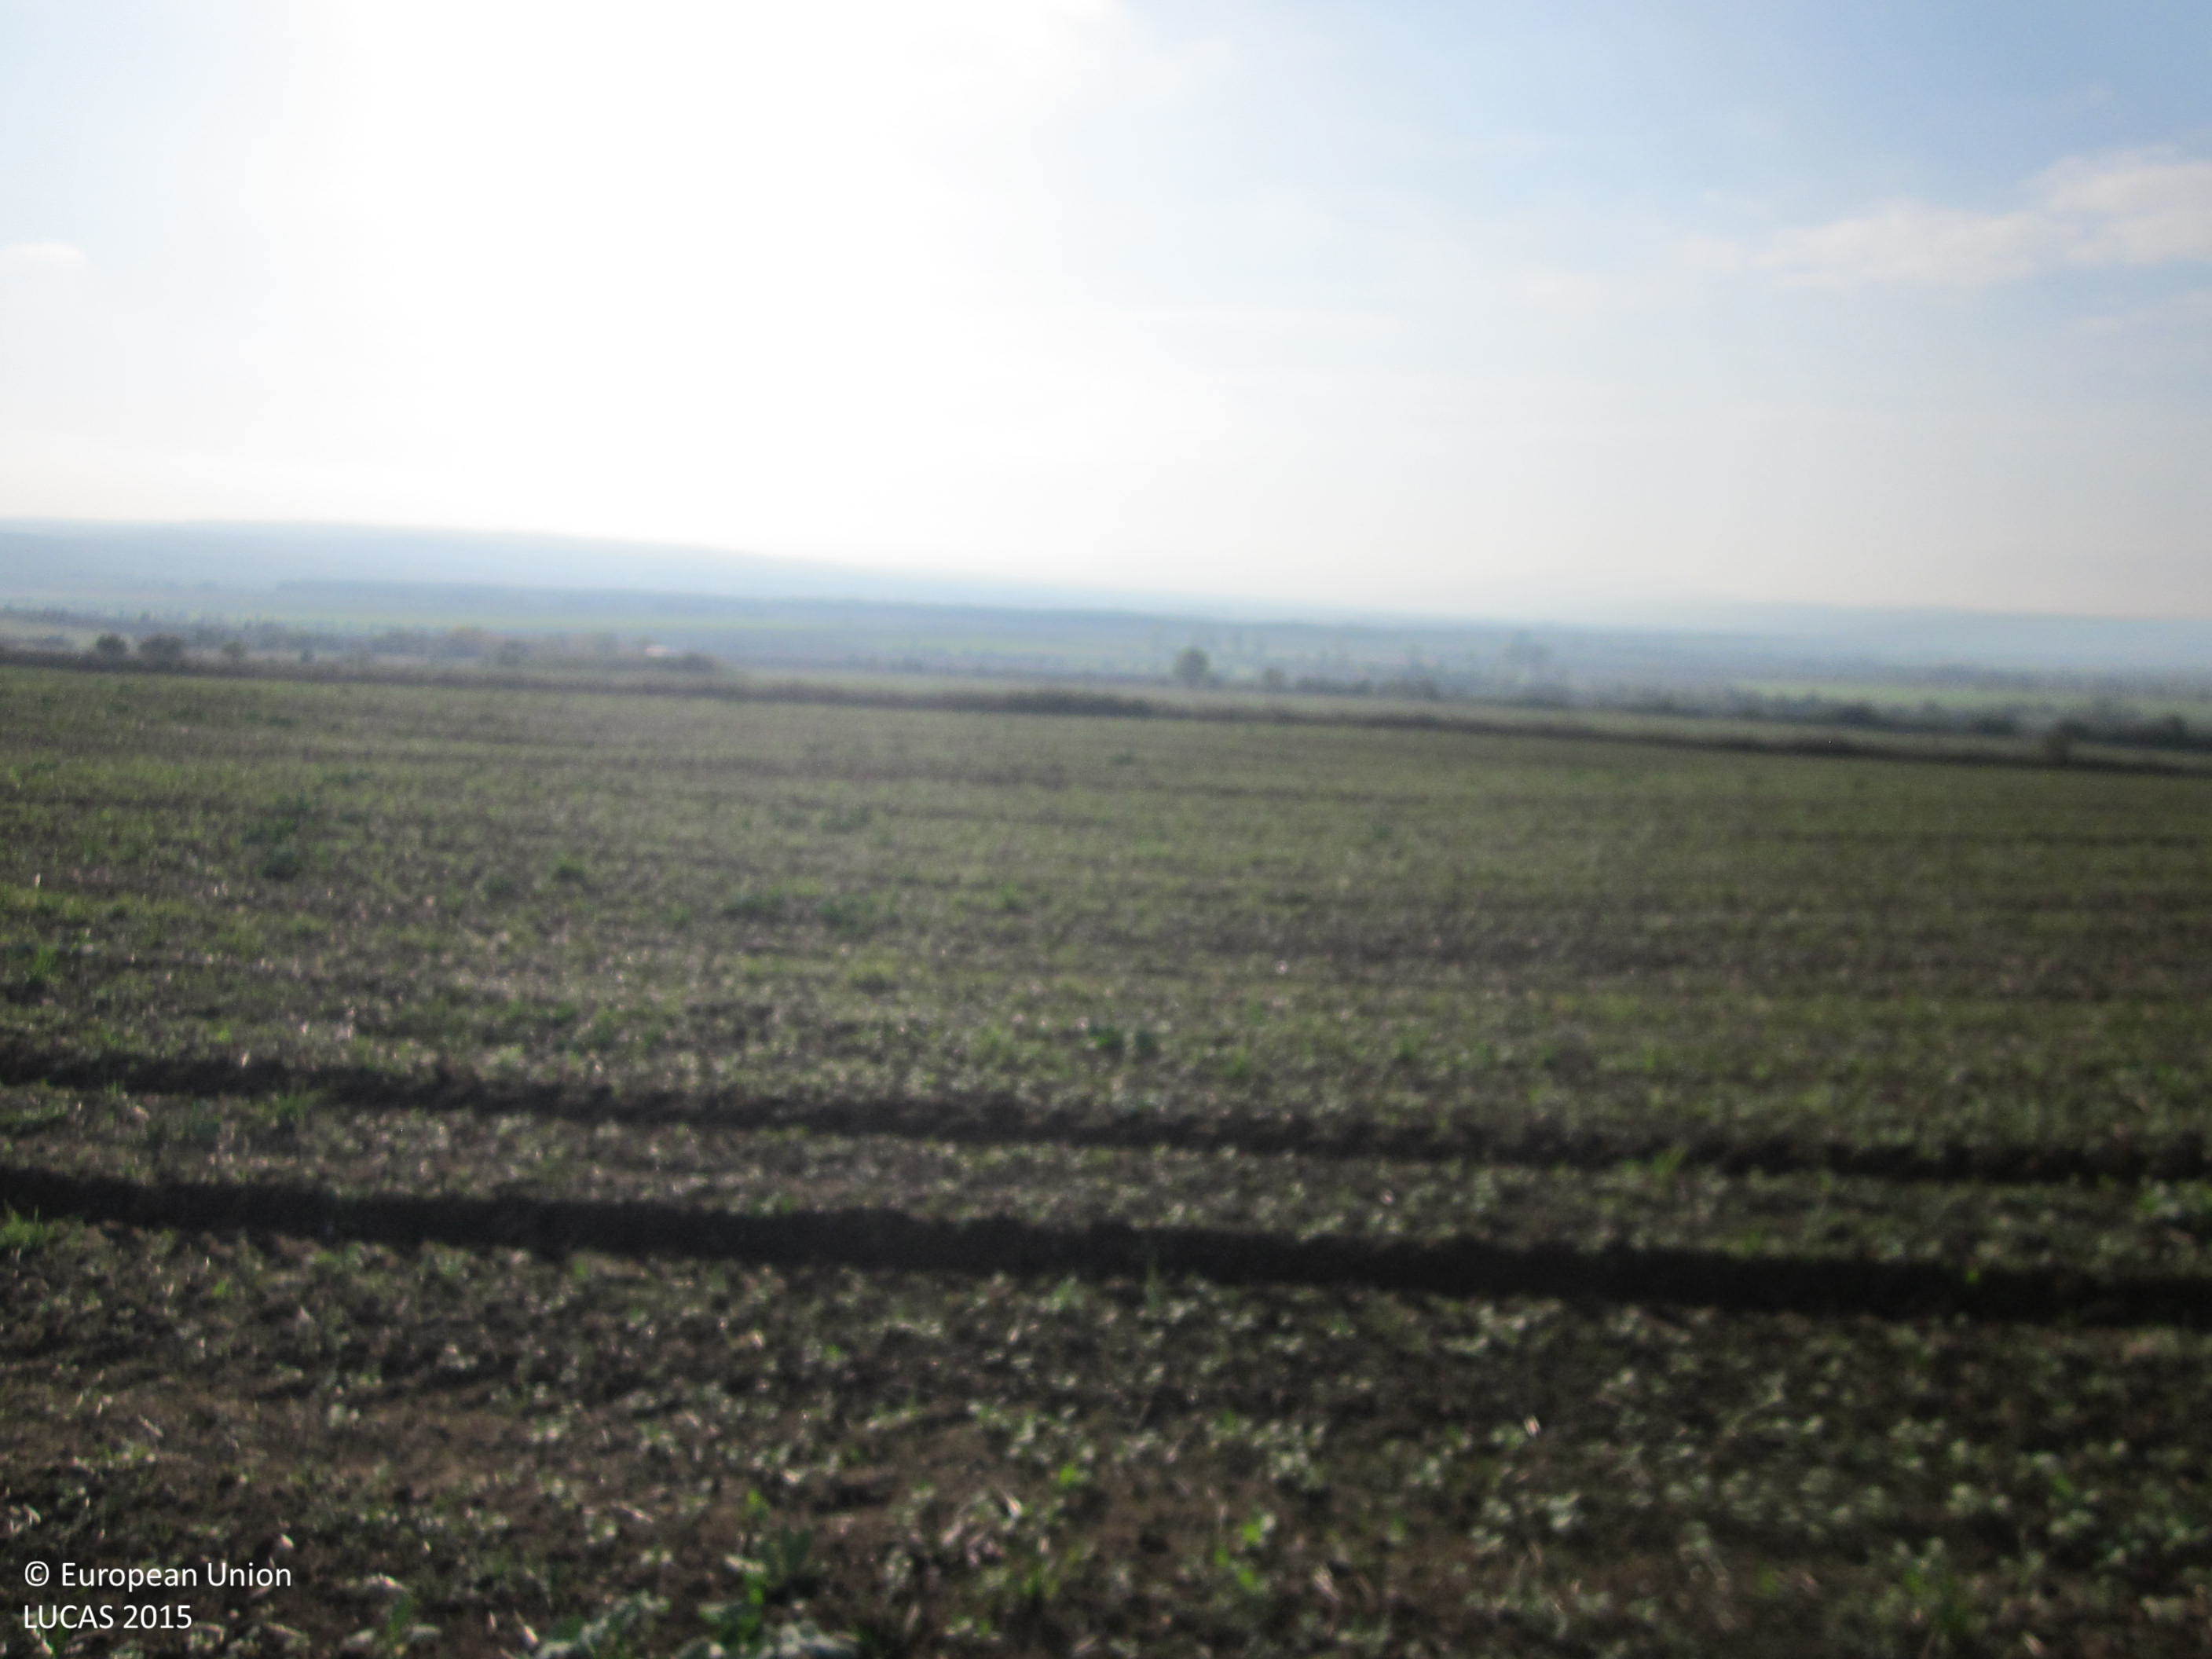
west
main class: Cropland
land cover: Rape and turnip rape
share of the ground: 10 - 25 %
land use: Agriculture (excluding fallow land and kitchen gardens)
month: October
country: BG
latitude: 42.7530
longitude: 26.8801
